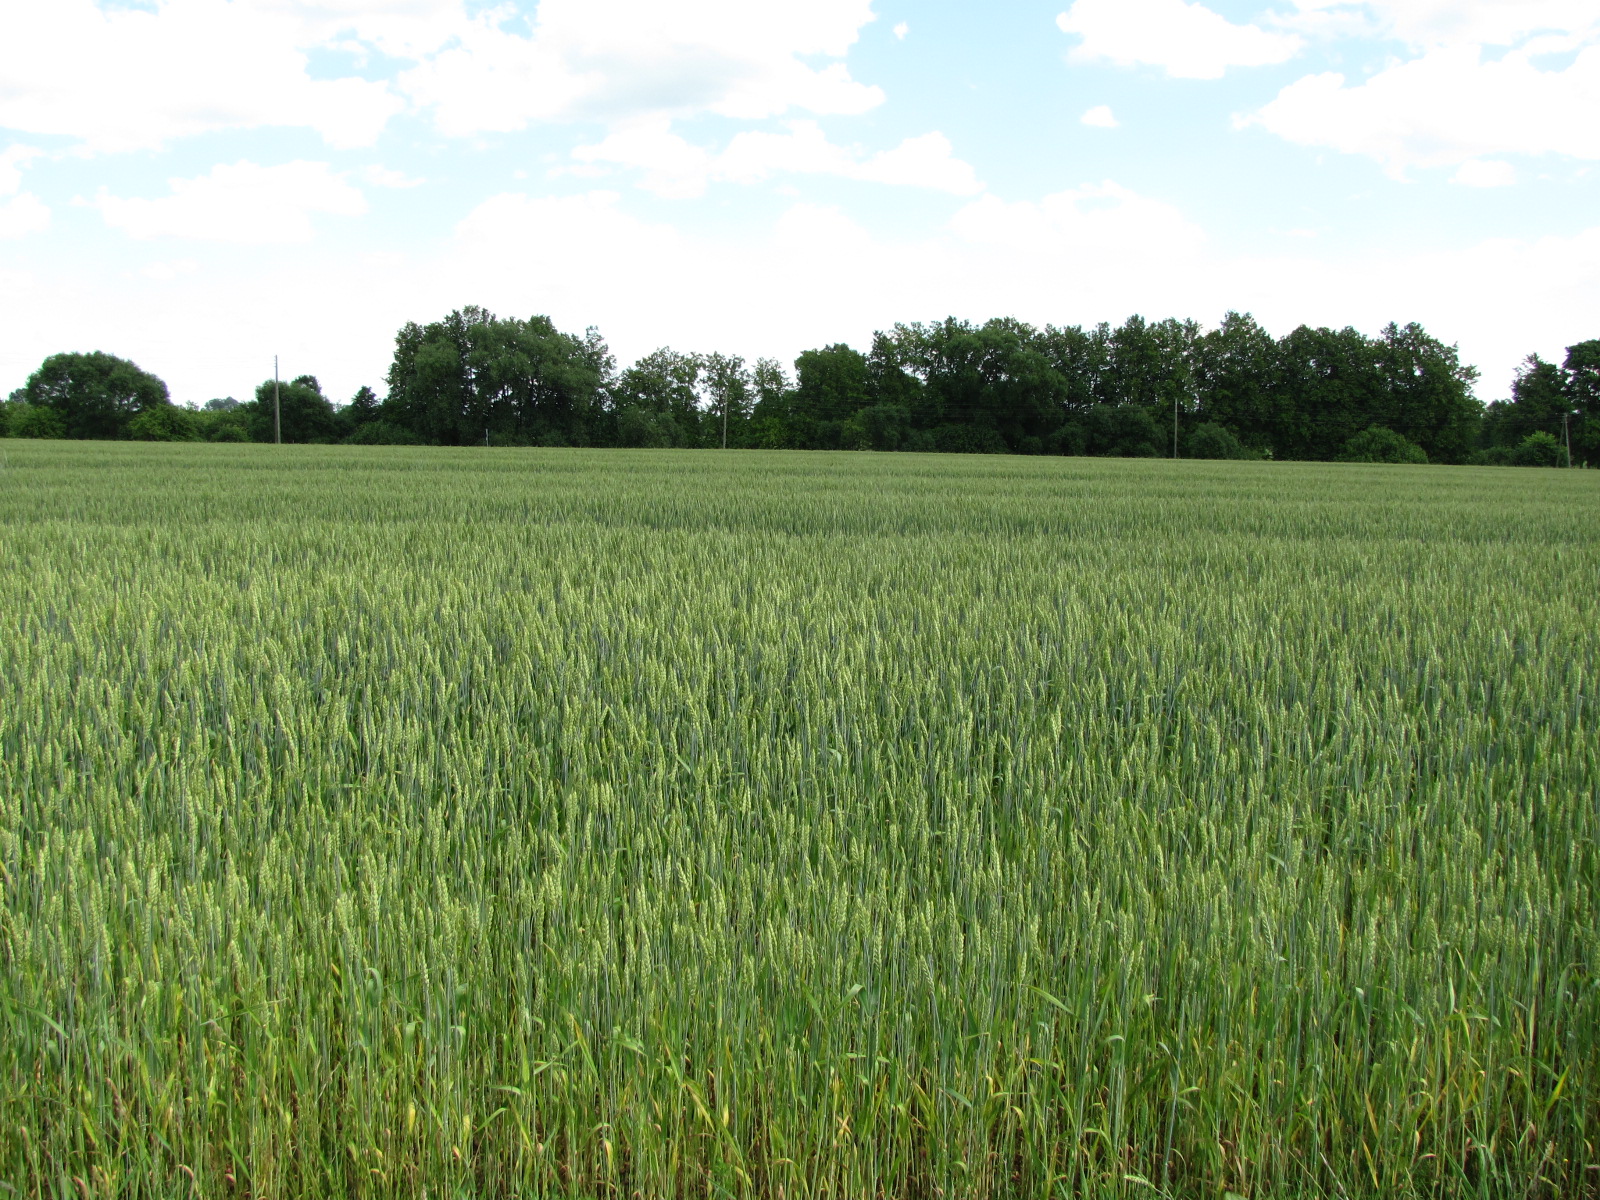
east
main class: Cropland
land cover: Rape and turnip rape
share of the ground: > 75 %
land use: Agriculture (excluding fallow land and kitchen gardens)
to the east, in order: Rape and turnip rape; Grass margins; Tracks; Common wheat; Grassland without tree/shrub cover; Paved roads, cycling and walking lanes; Spontaneously vegetated surfaces; Electric lines; Broadleaved woodland; Shruby margins; Rape and turnip rape
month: June
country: LV
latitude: 56.4298
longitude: 23.9154
